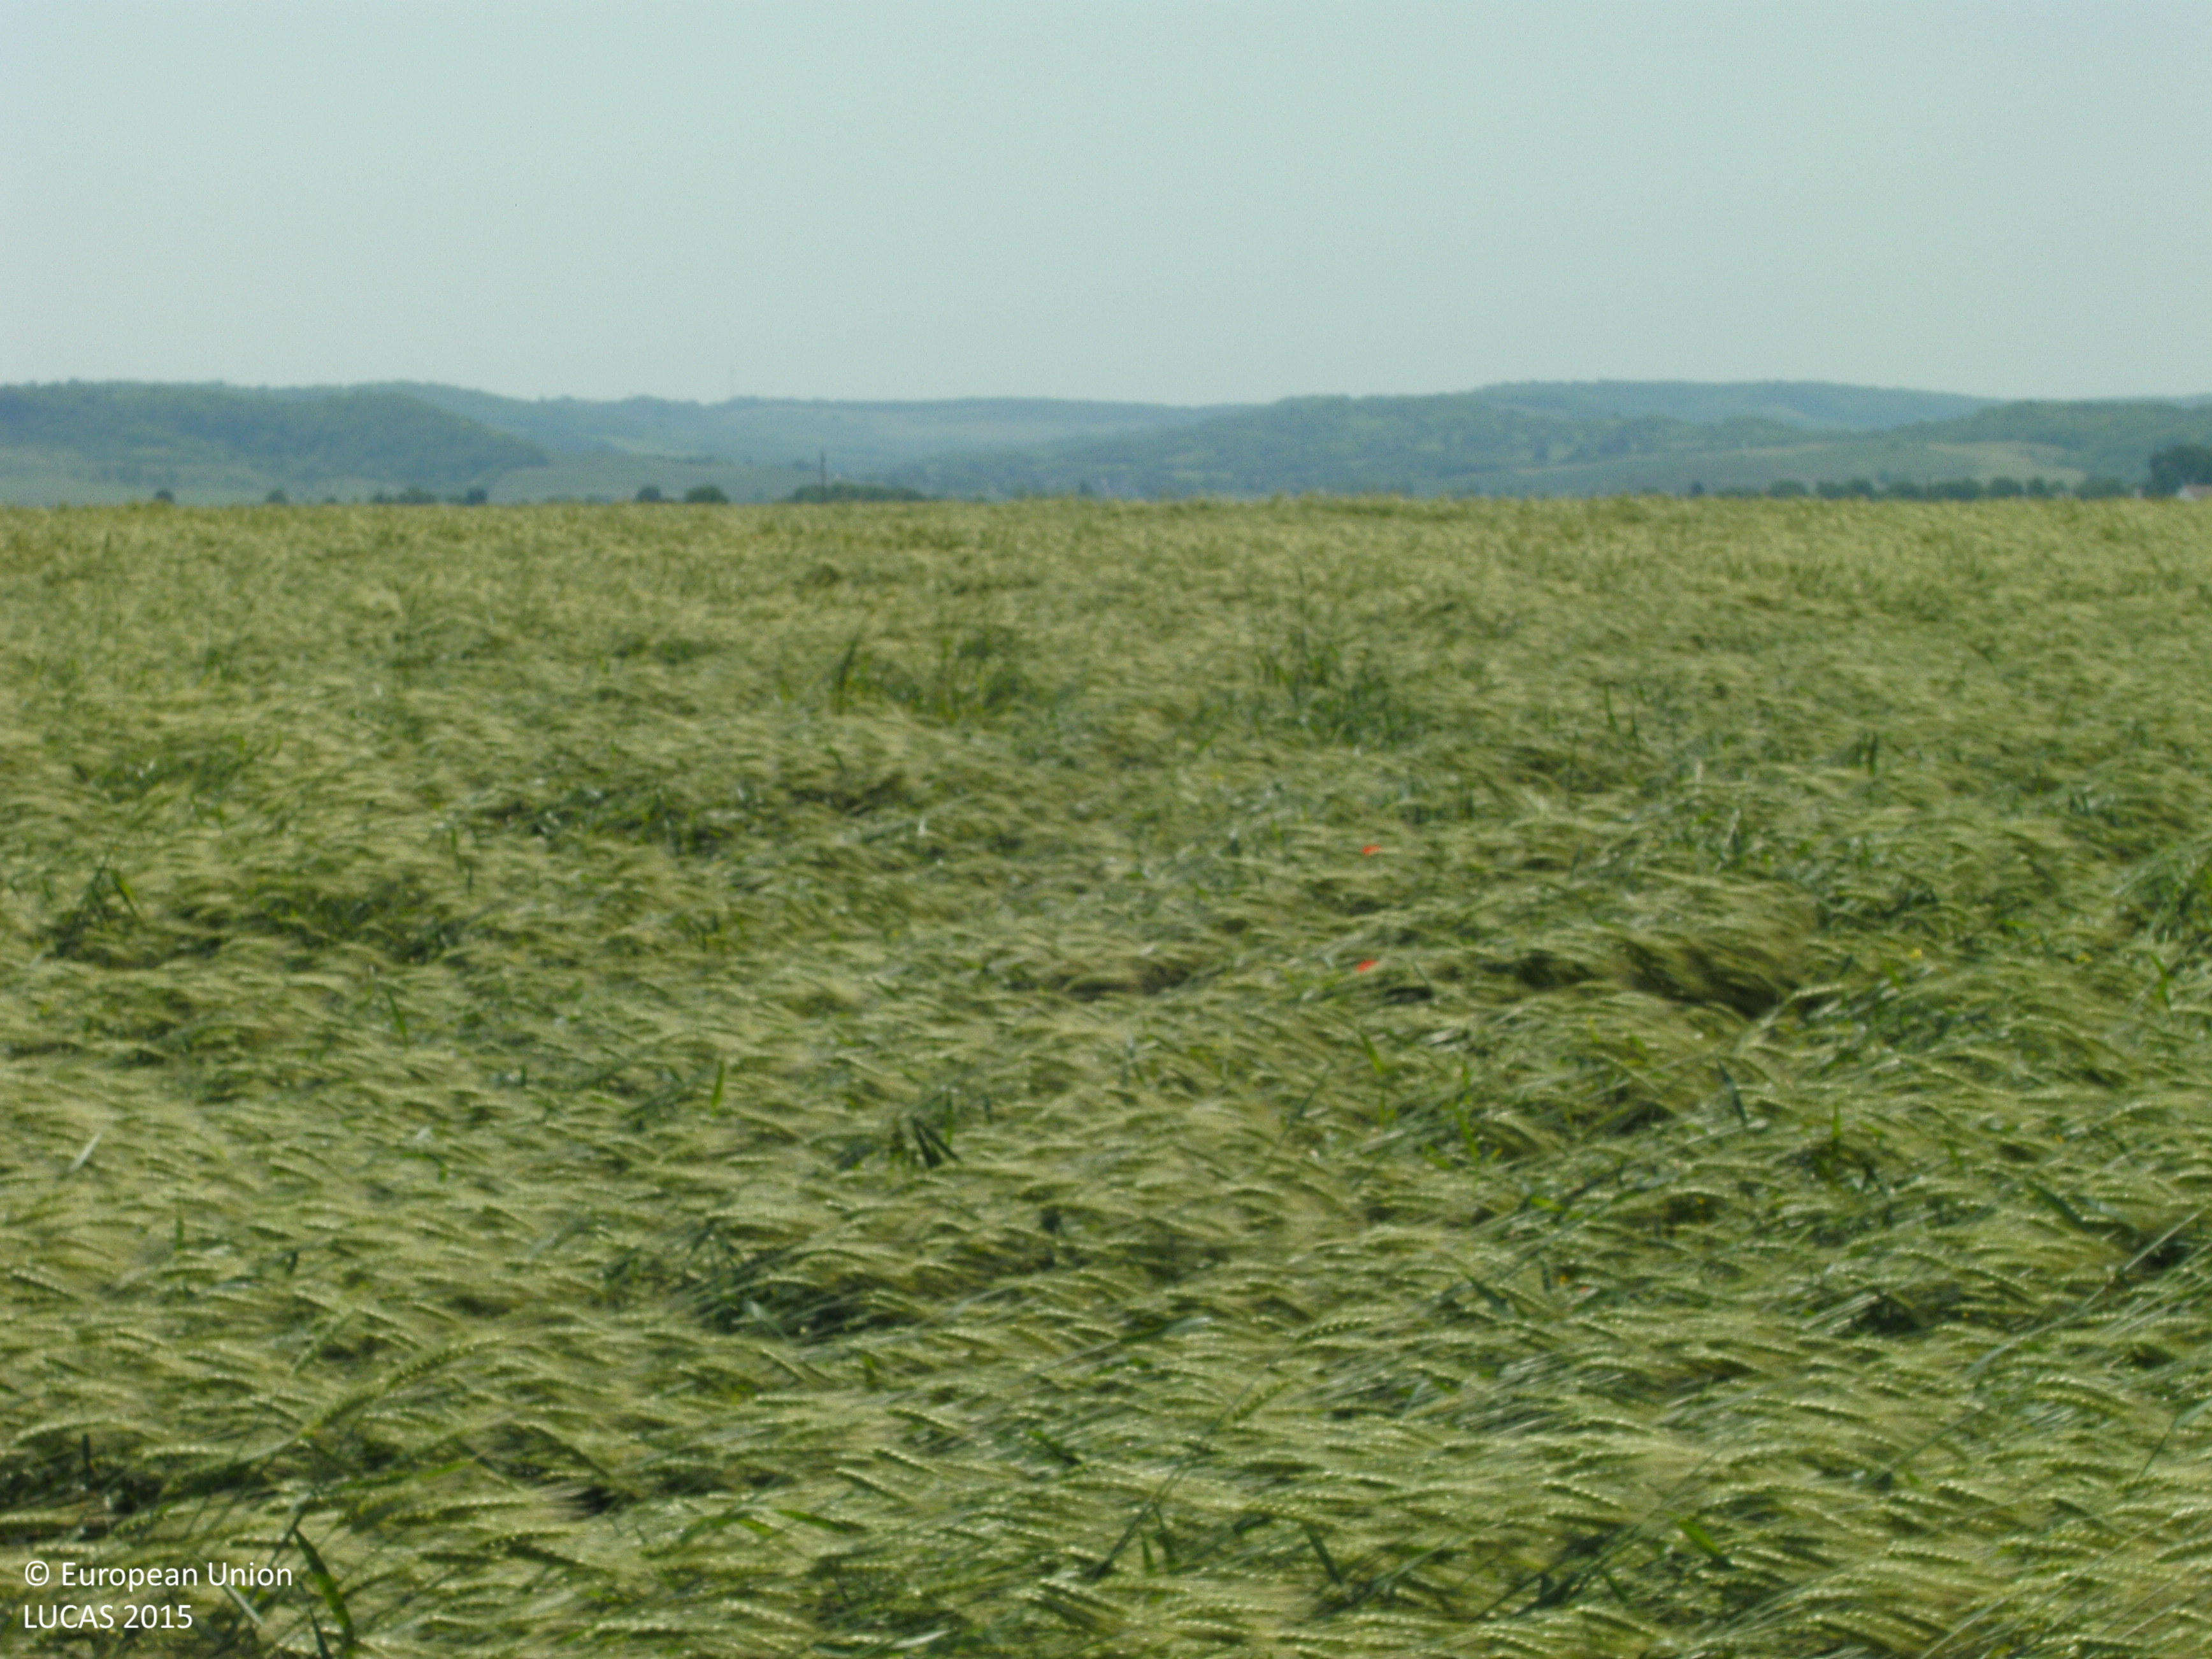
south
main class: Cropland
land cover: Common wheat
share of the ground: > 75 %
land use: Agriculture (excluding fallow land and kitchen gardens)
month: June
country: HU
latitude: 46.3787
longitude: 17.9767
